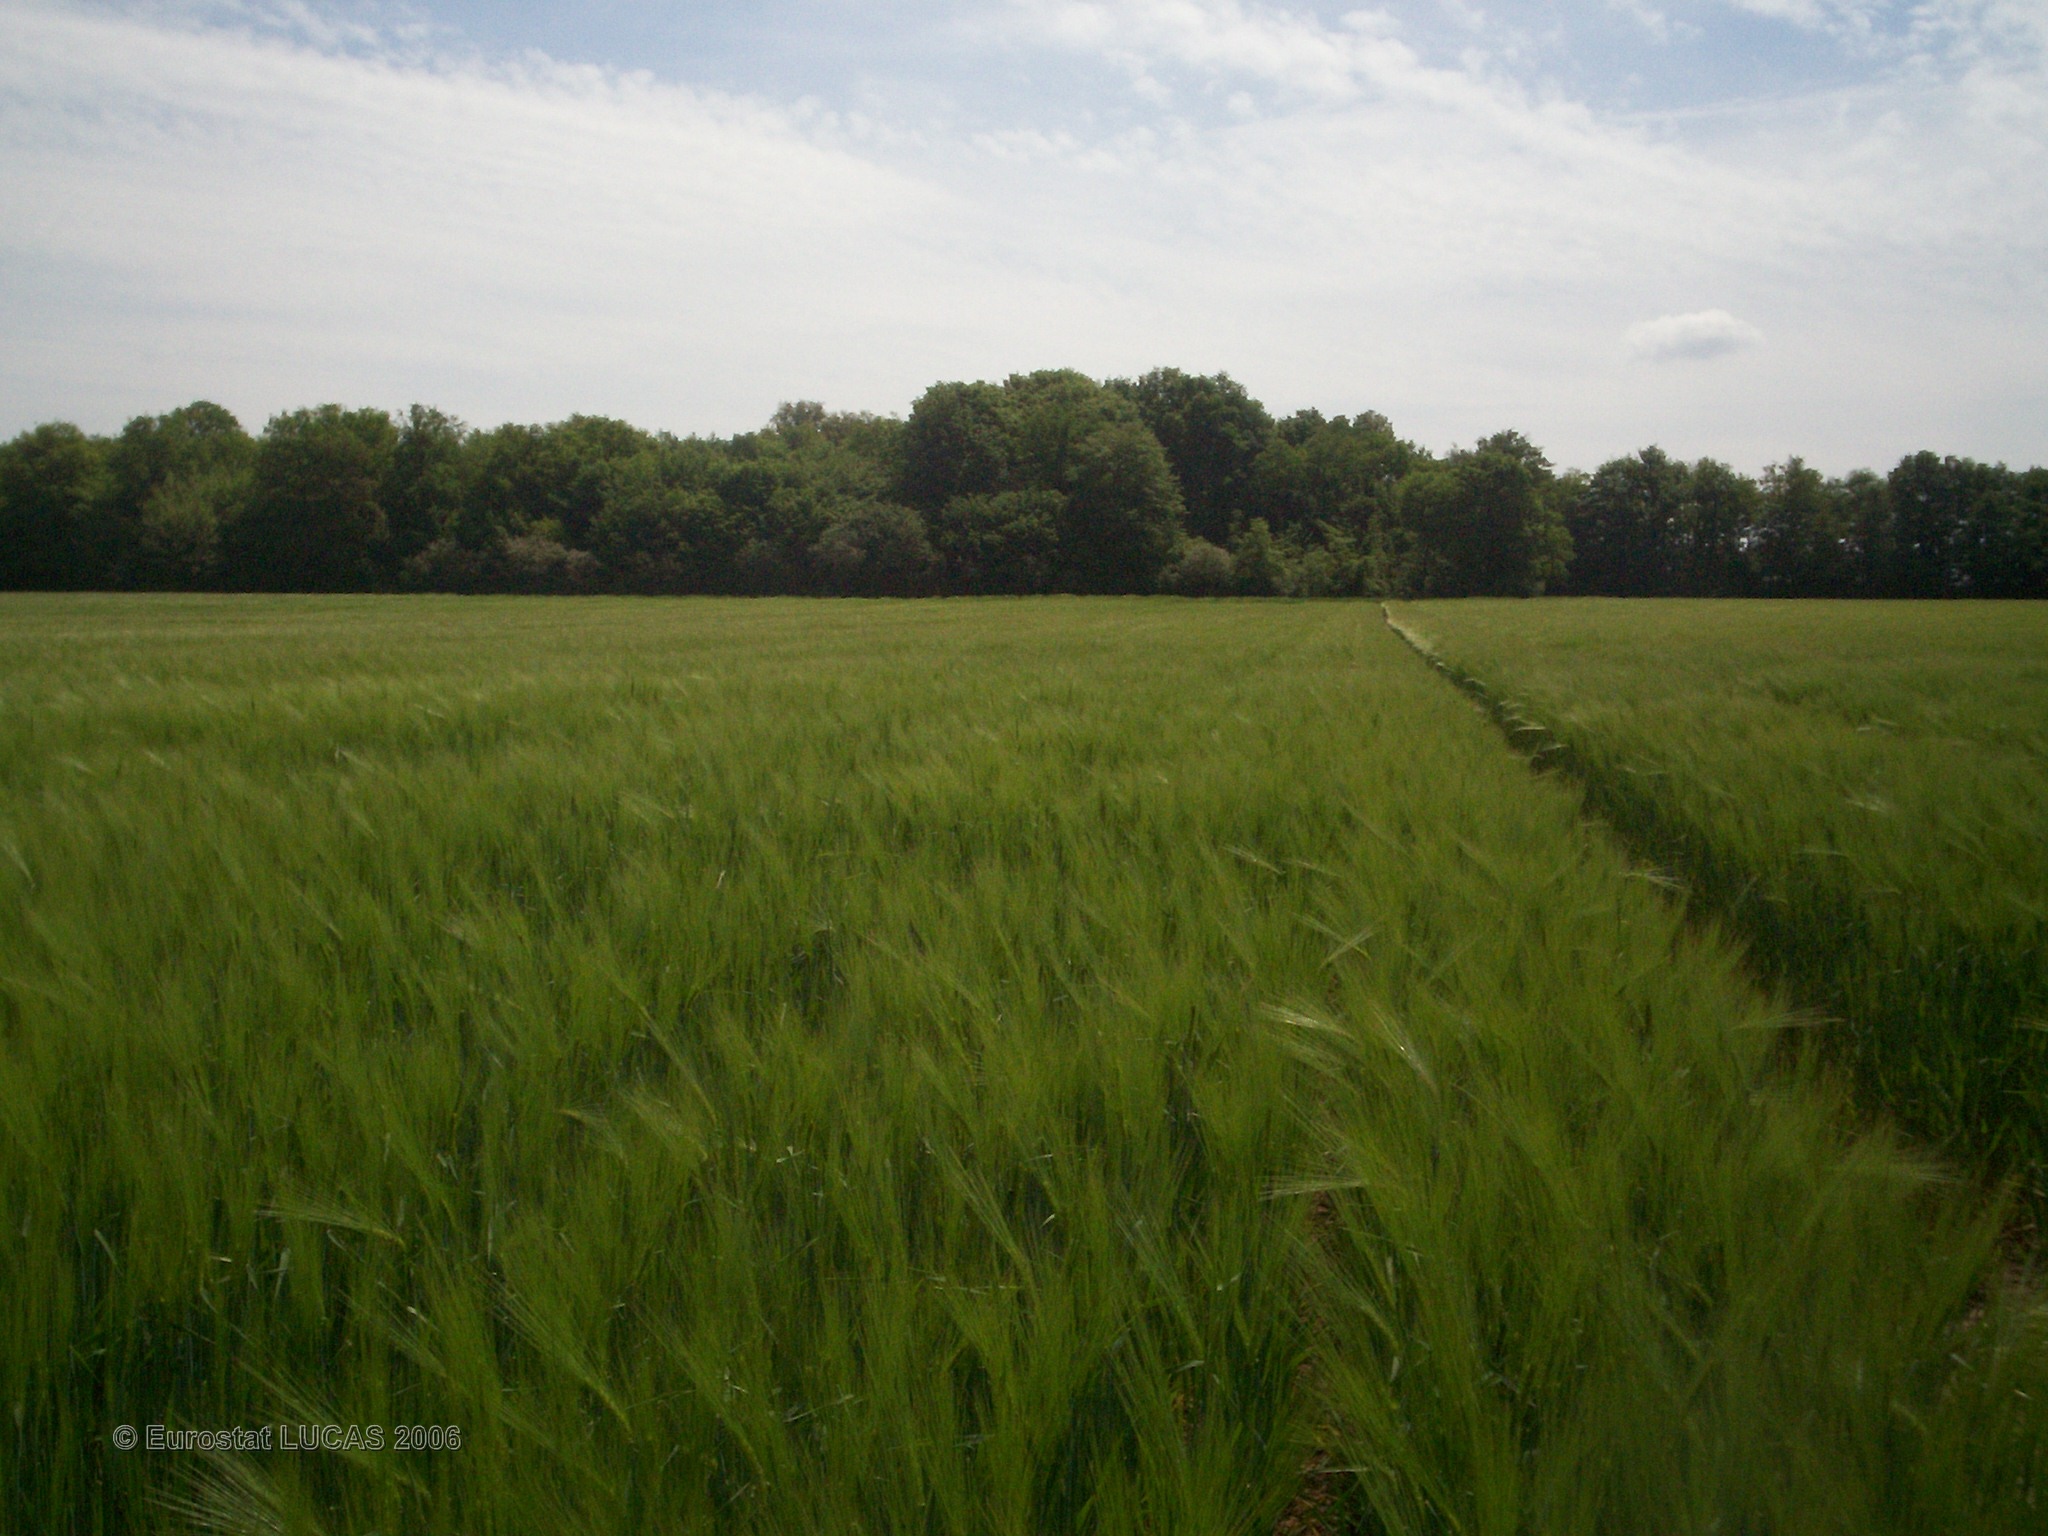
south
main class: Cropland
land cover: Barley
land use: Agriculture (excluding fallow land and kitchen gardens)
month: May
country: FR
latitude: 47.6563
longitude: 2.9769
